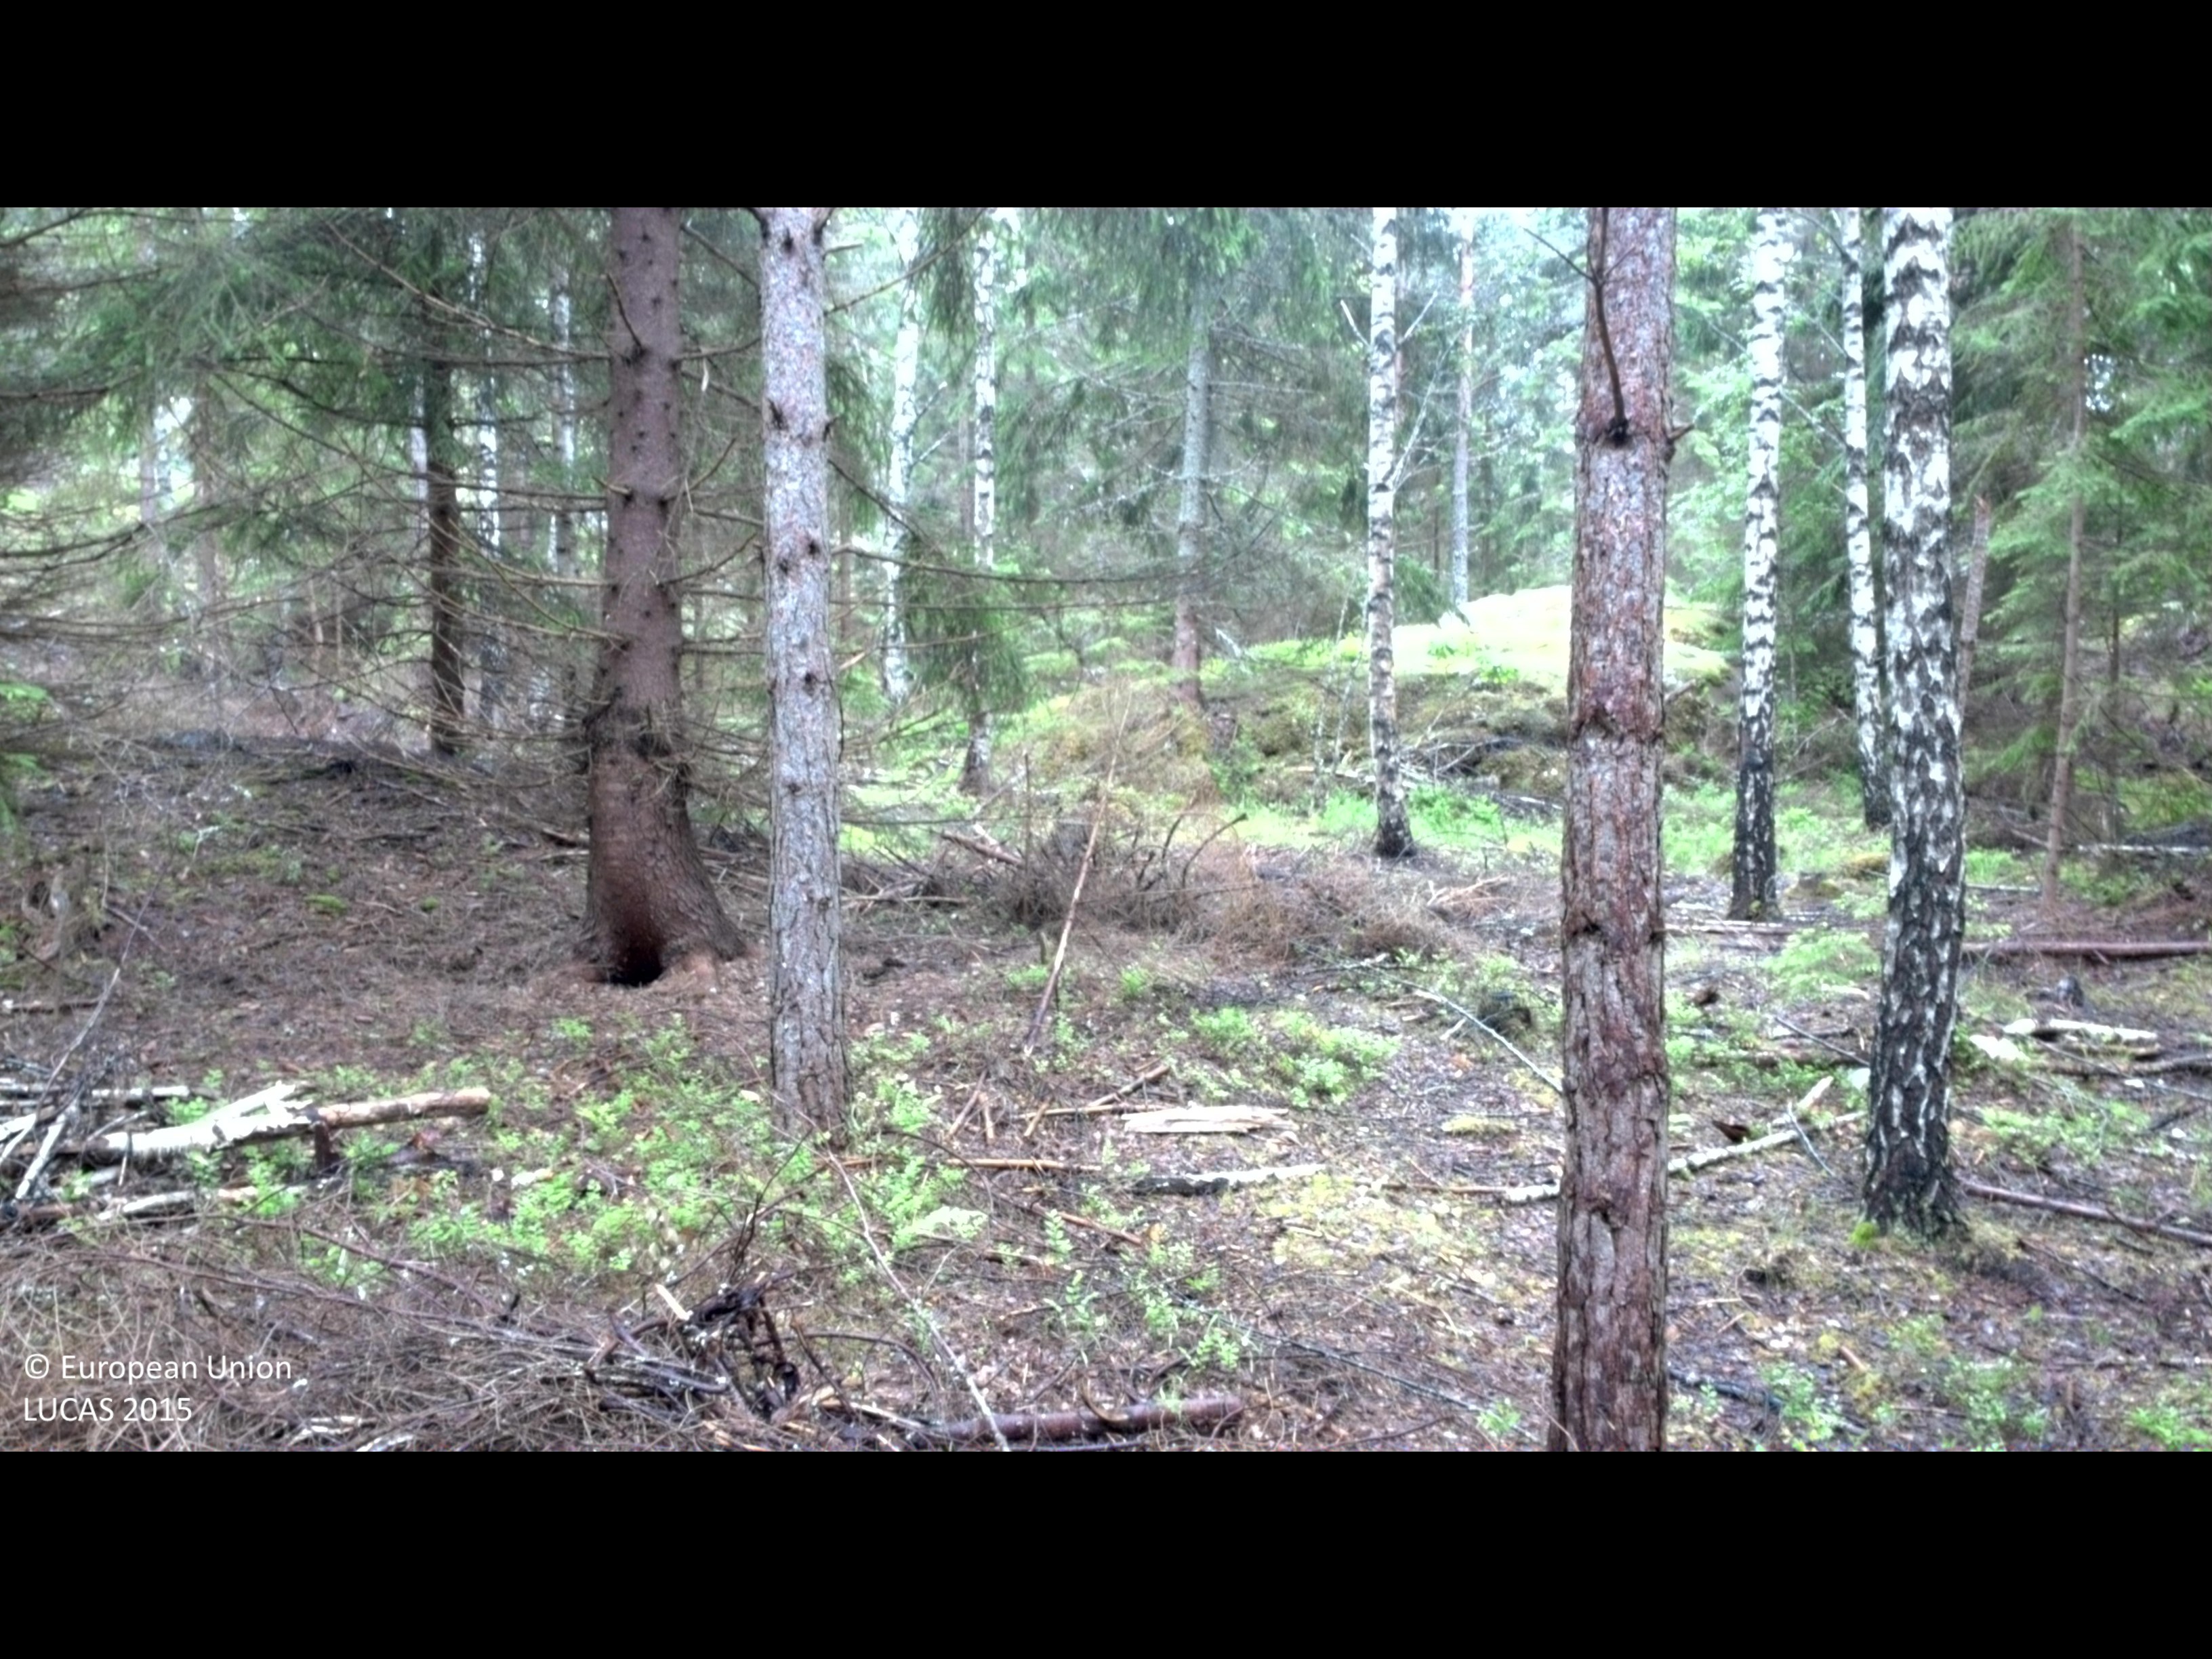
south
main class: Woodland
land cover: Spruce dominated mixed woodland
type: boreal forest
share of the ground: 50 - 75 %
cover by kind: coniferous forest trees 35 %, broadleaved forest trees 30 %, shrubs 15 %, lichens and mosses 10 %, unconsolidated bare surface 10 %
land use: Forestry
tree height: > 5 m
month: June
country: SE
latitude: 57.9635
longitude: 16.3017
